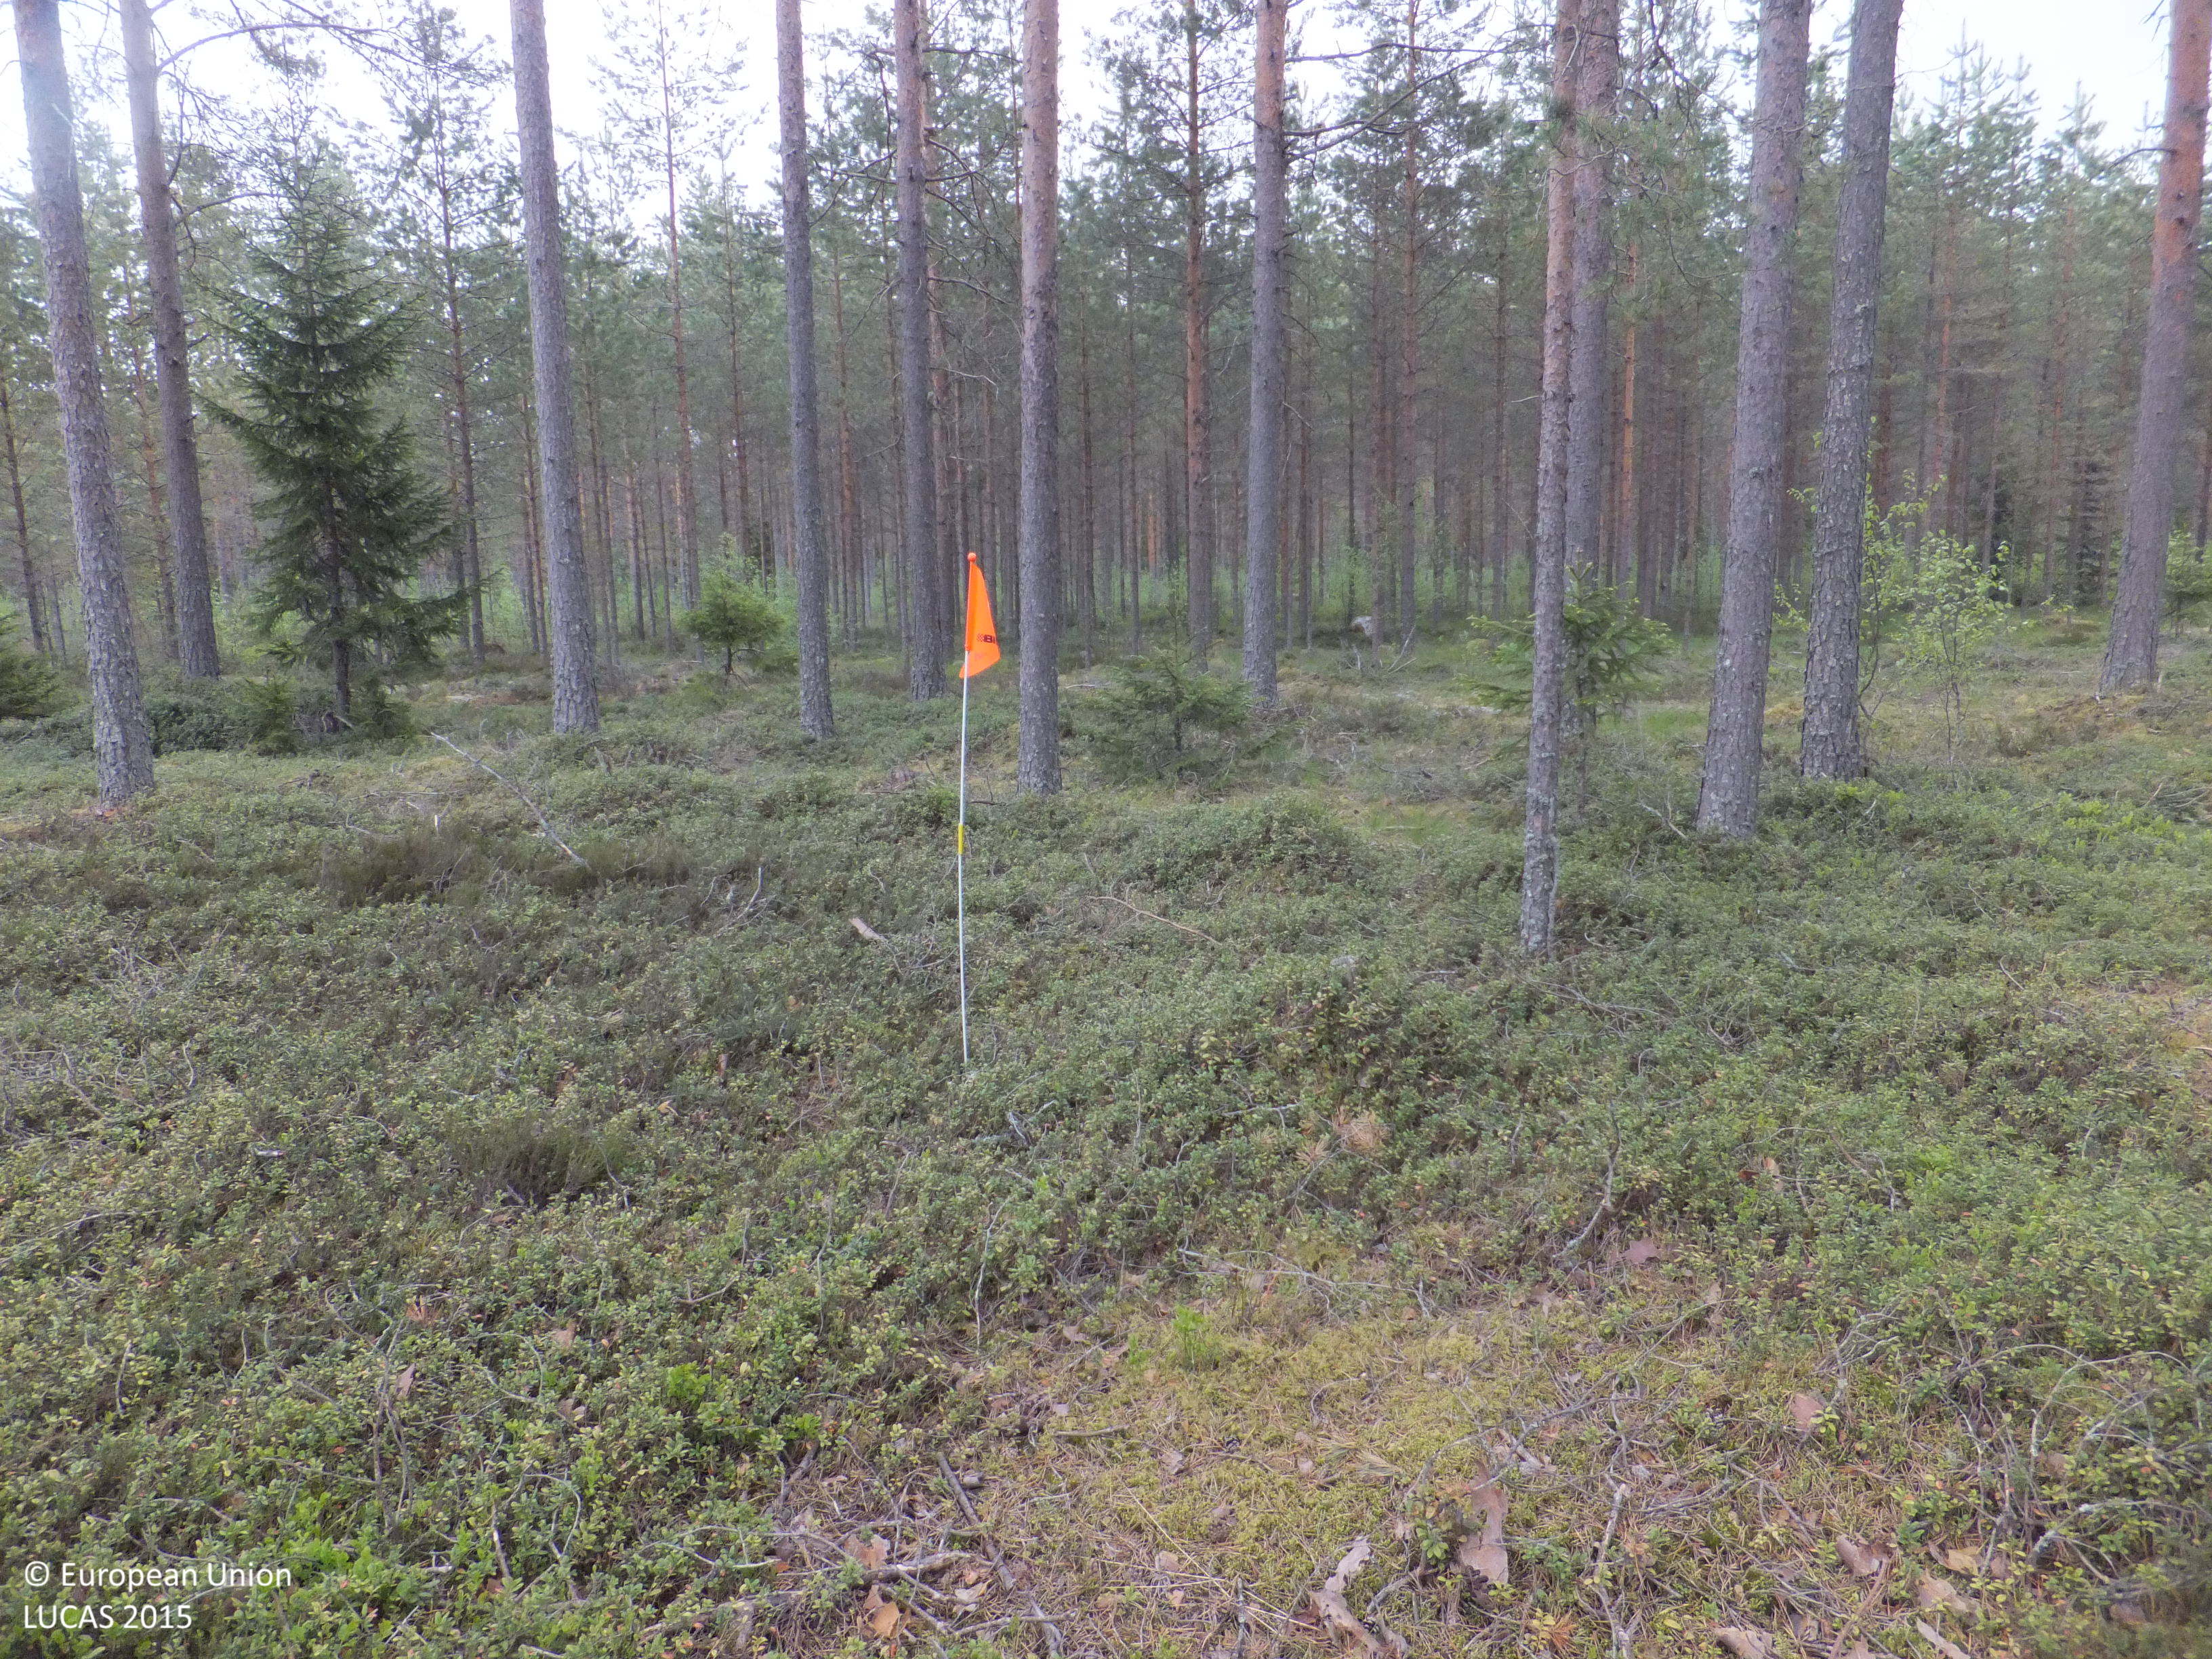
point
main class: Woodland
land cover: Pine dominated coniferous woodland
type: boreal forest
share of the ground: > 75 %
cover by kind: coniferous forest trees 90 %, shrubs 5 %, lichens and mosses 5 %
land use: Forestry
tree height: > 5 m
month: June
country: FI
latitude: 63.5130
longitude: 22.7722
